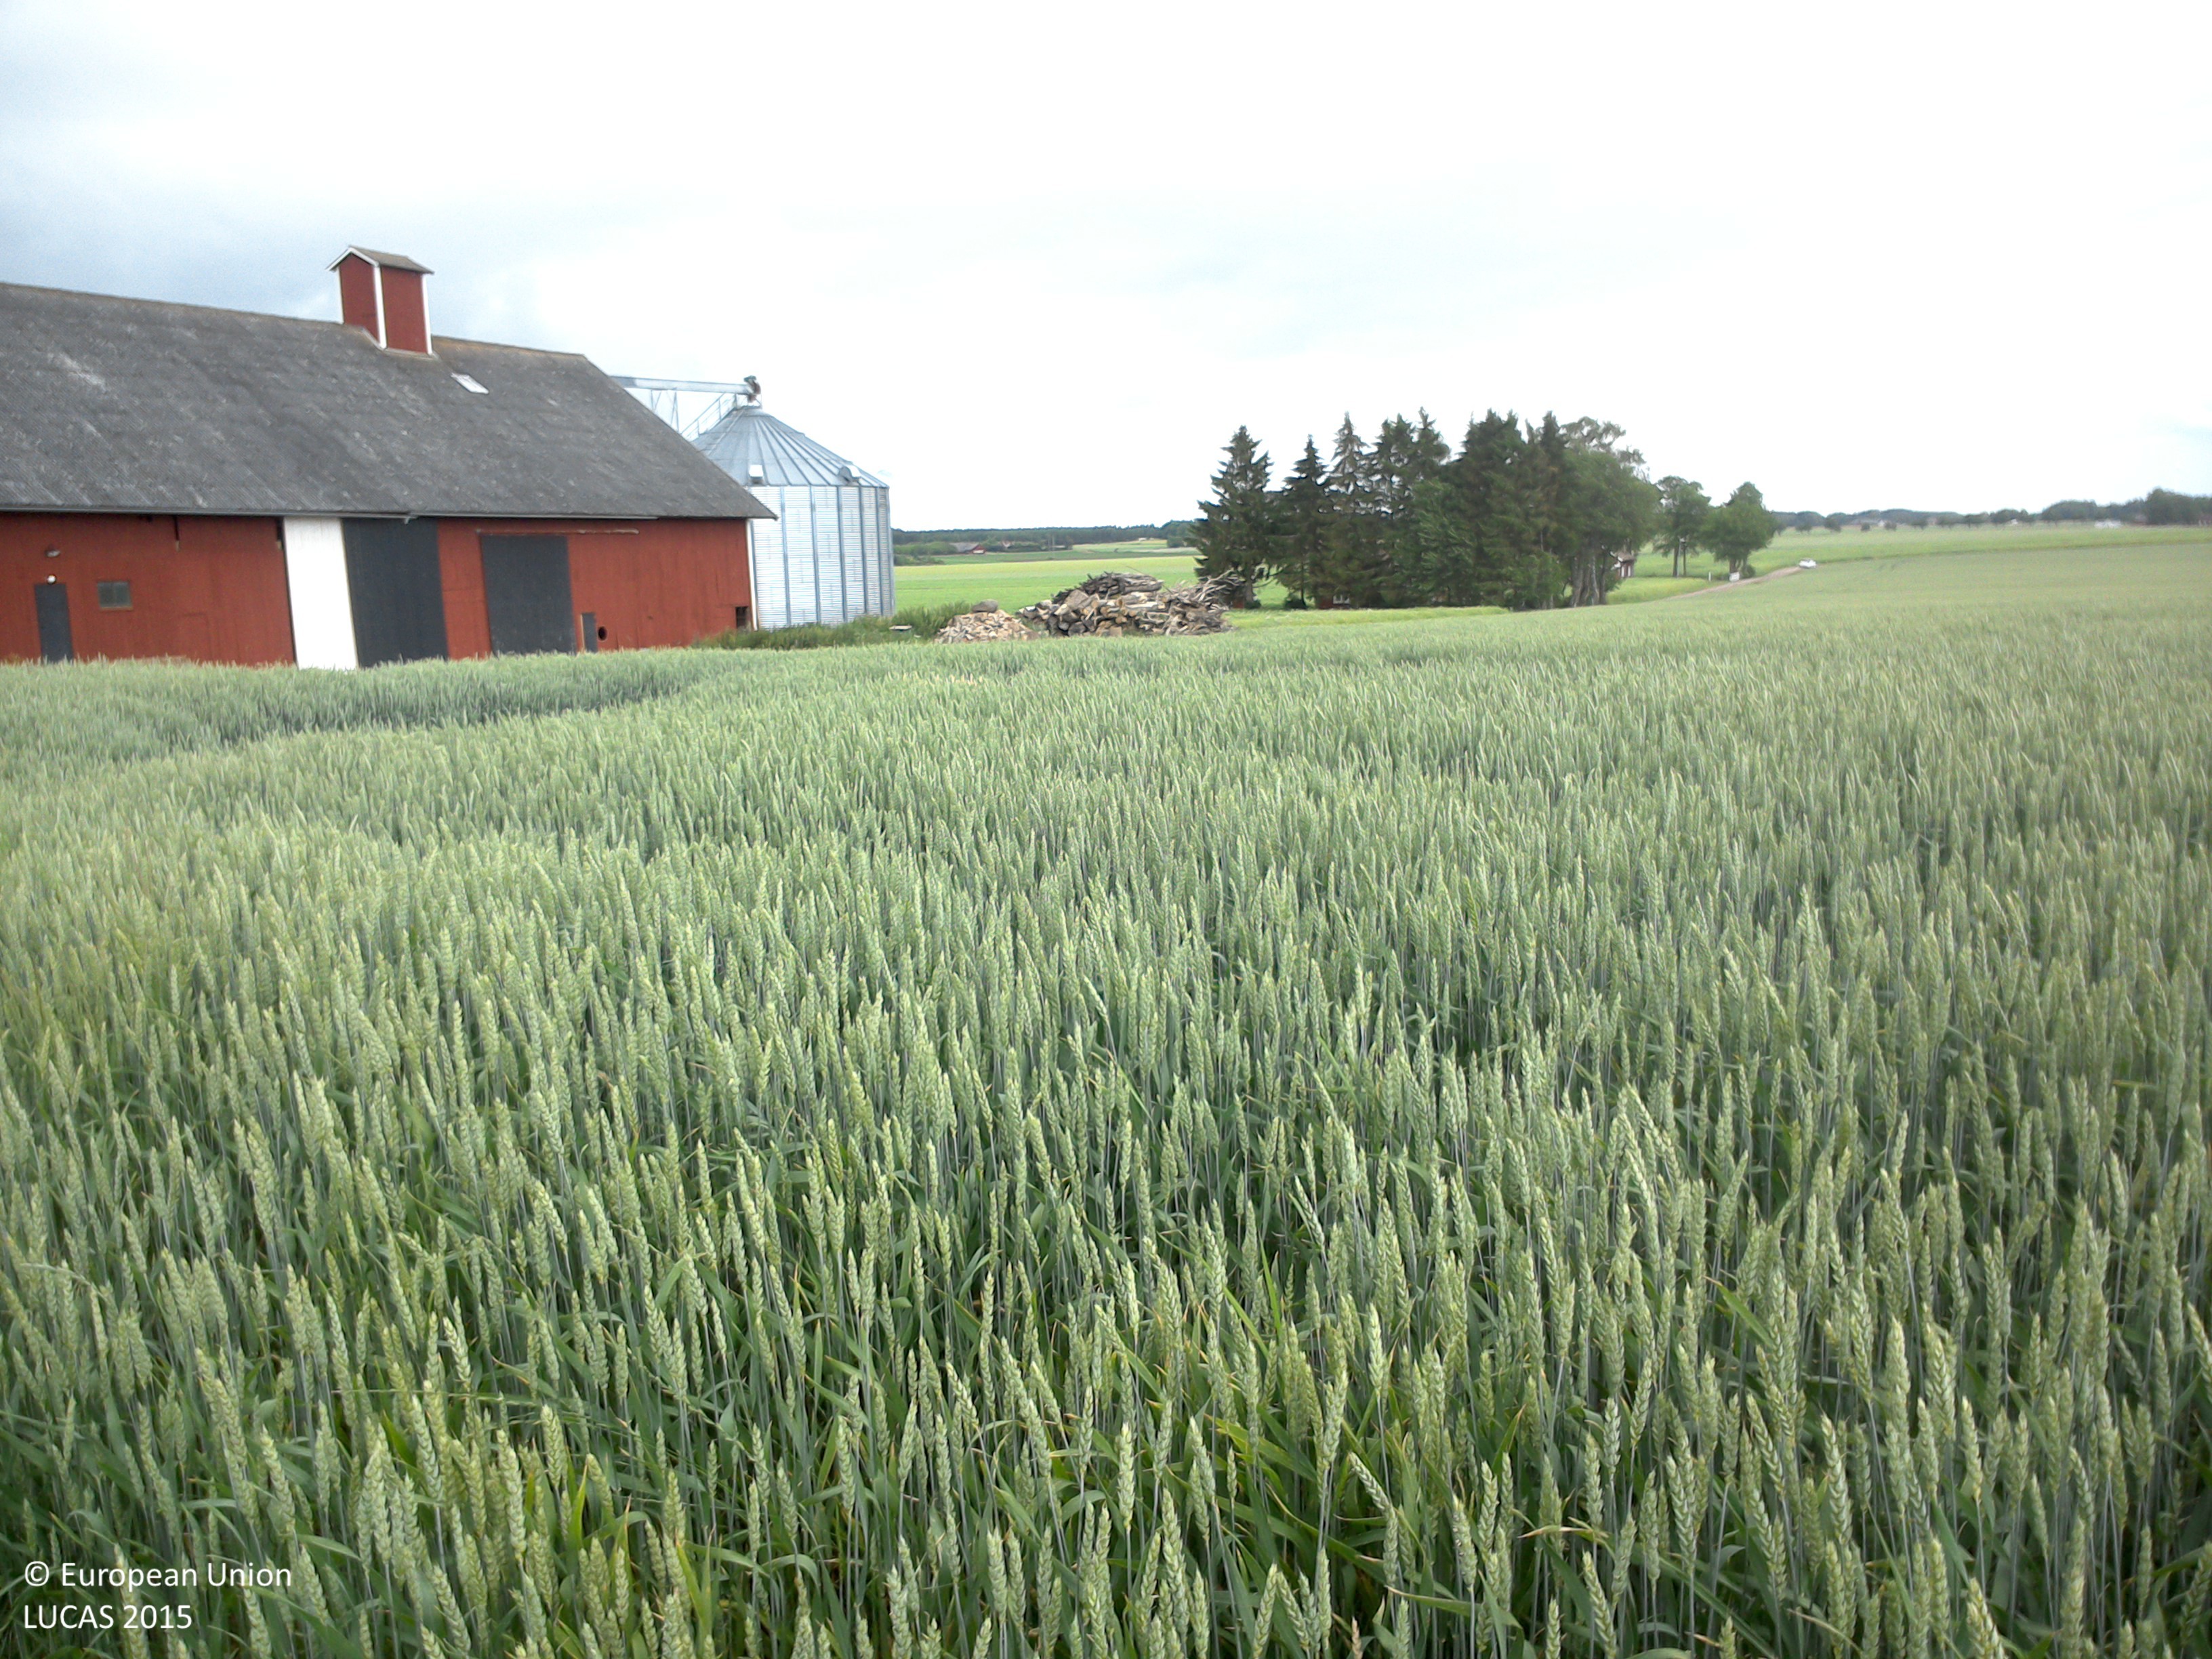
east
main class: Cropland
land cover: Common wheat
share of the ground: > 75 %
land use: Agriculture (excluding fallow land and kitchen gardens)
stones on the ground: < 10 %
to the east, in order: Common wheat; Grass margins; Paved roads, cycling and walking lanes; Grassland without tree/shrub cover; Artificial constructions in urban areas; Dry pulses
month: July
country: SE
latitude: 58.5018
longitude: 15.0903
